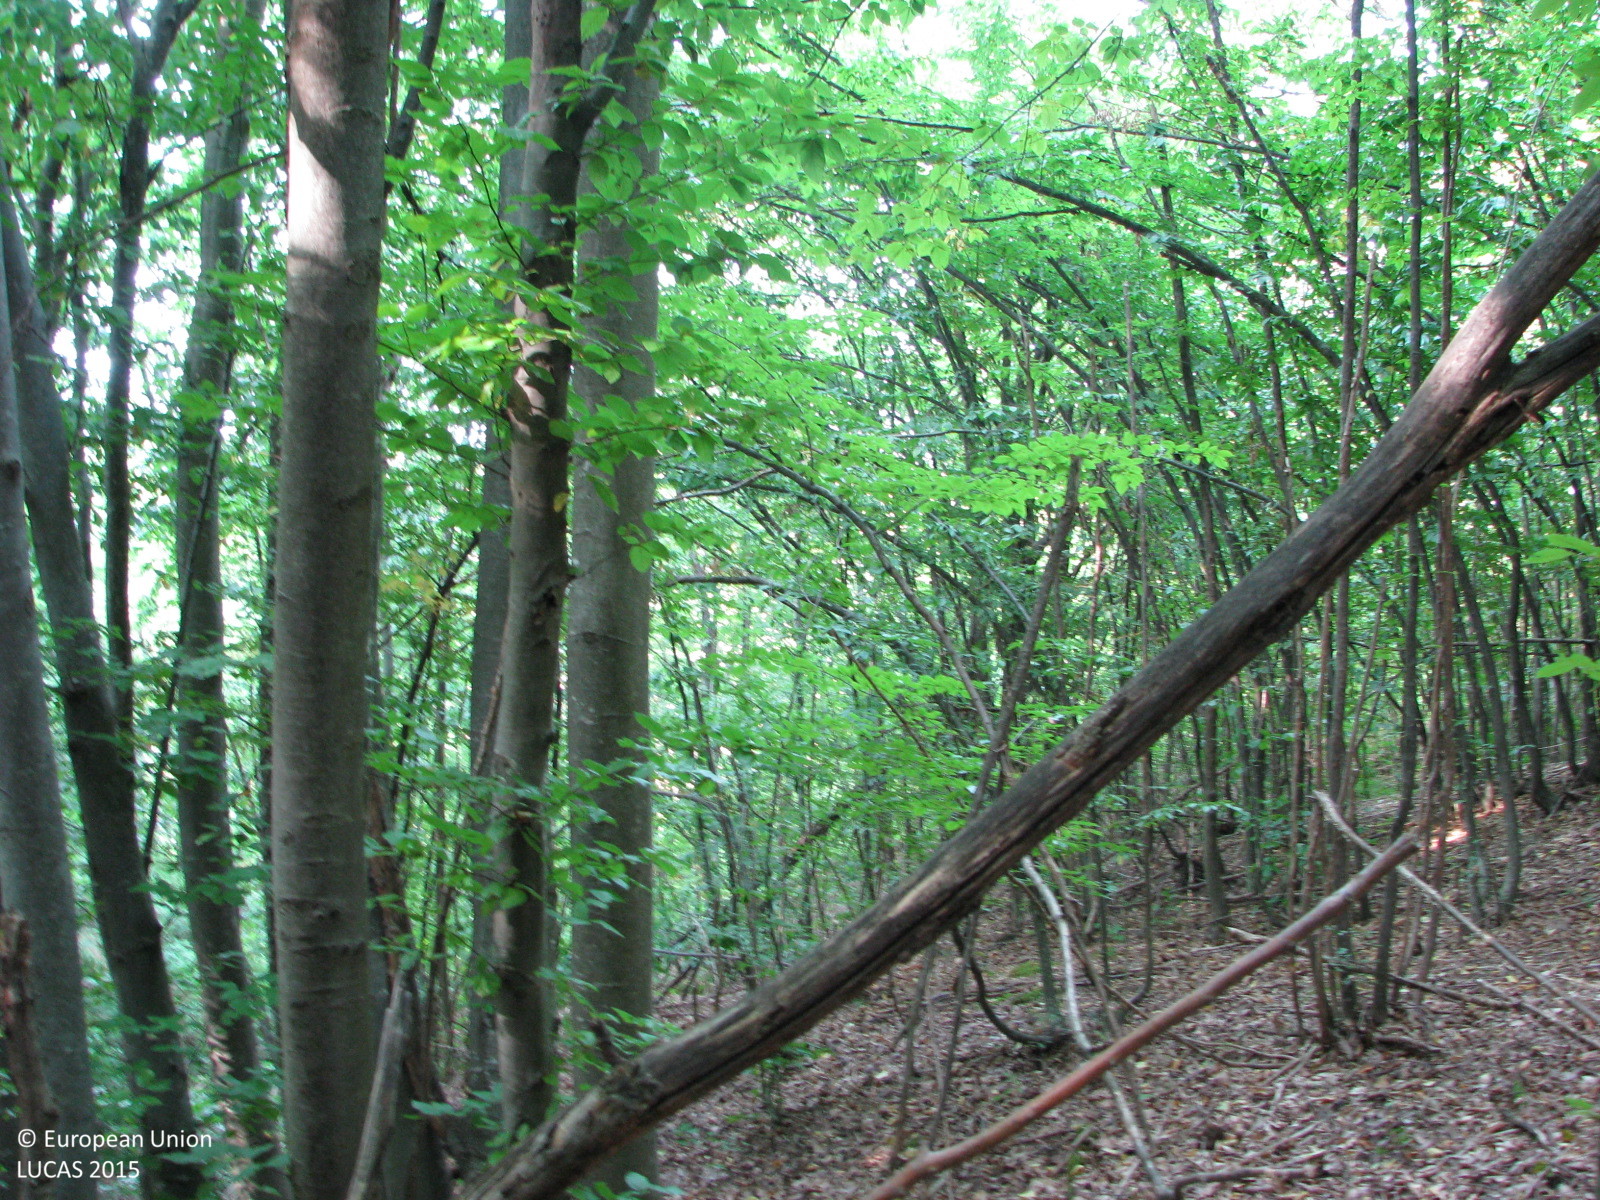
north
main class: Woodland
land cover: Broadleaved woodland
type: beech forest
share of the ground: 50 - 75 %
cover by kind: broadleaved forest trees 60 %, consolidated bare surface 25 %, shrubs 10 %, herbaceous plants 5 %
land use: Forestry
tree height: > 5 m
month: August
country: BG
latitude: 42.8791
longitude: 26.1138
